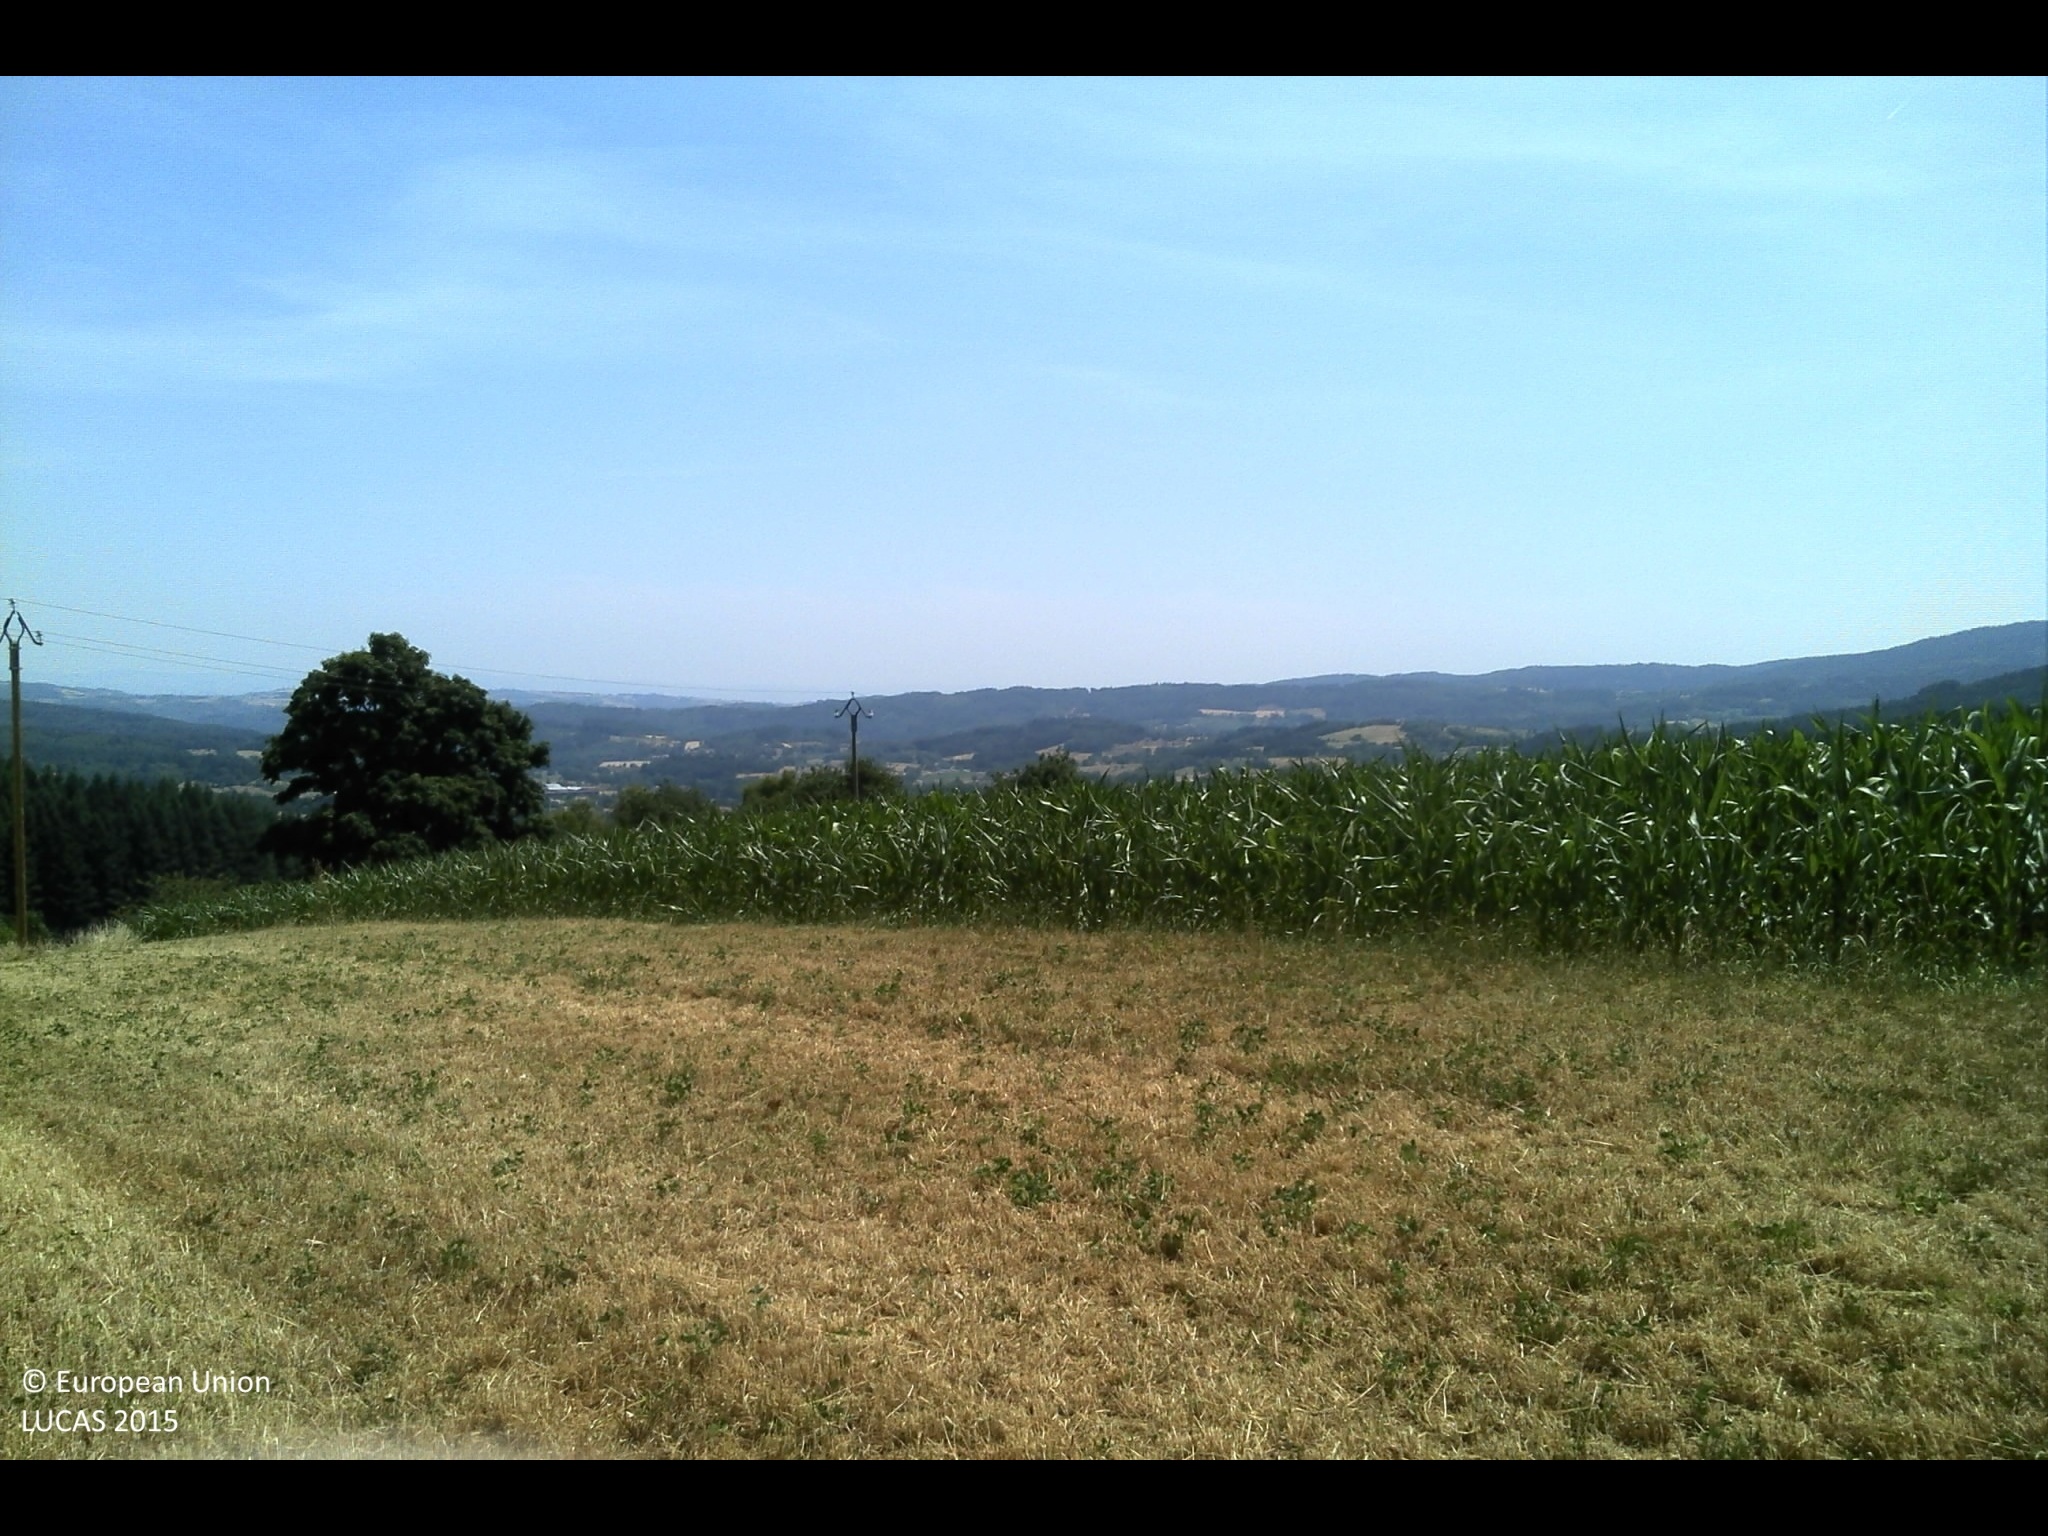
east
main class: Cropland
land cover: Temporary grasslands
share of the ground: > 75 %
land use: Agriculture (excluding fallow land and kitchen gardens)
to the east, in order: Temporary grasslands; Grass margins; Maize; Electric lines; Maize; Lines of trees; Spontaneously vegetated surfaces; Ditches and canals; Paved roads, cycling and walking lanes; Grass margins; Fences; Spontaneously vegetated surfaces; Electric lines; Spontaneously vegetated surfaces; Fences; Broadleaved woodland; Spontaneously vegetated surfaces; Maize
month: July
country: FR
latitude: 45.8062
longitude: 3.7350
